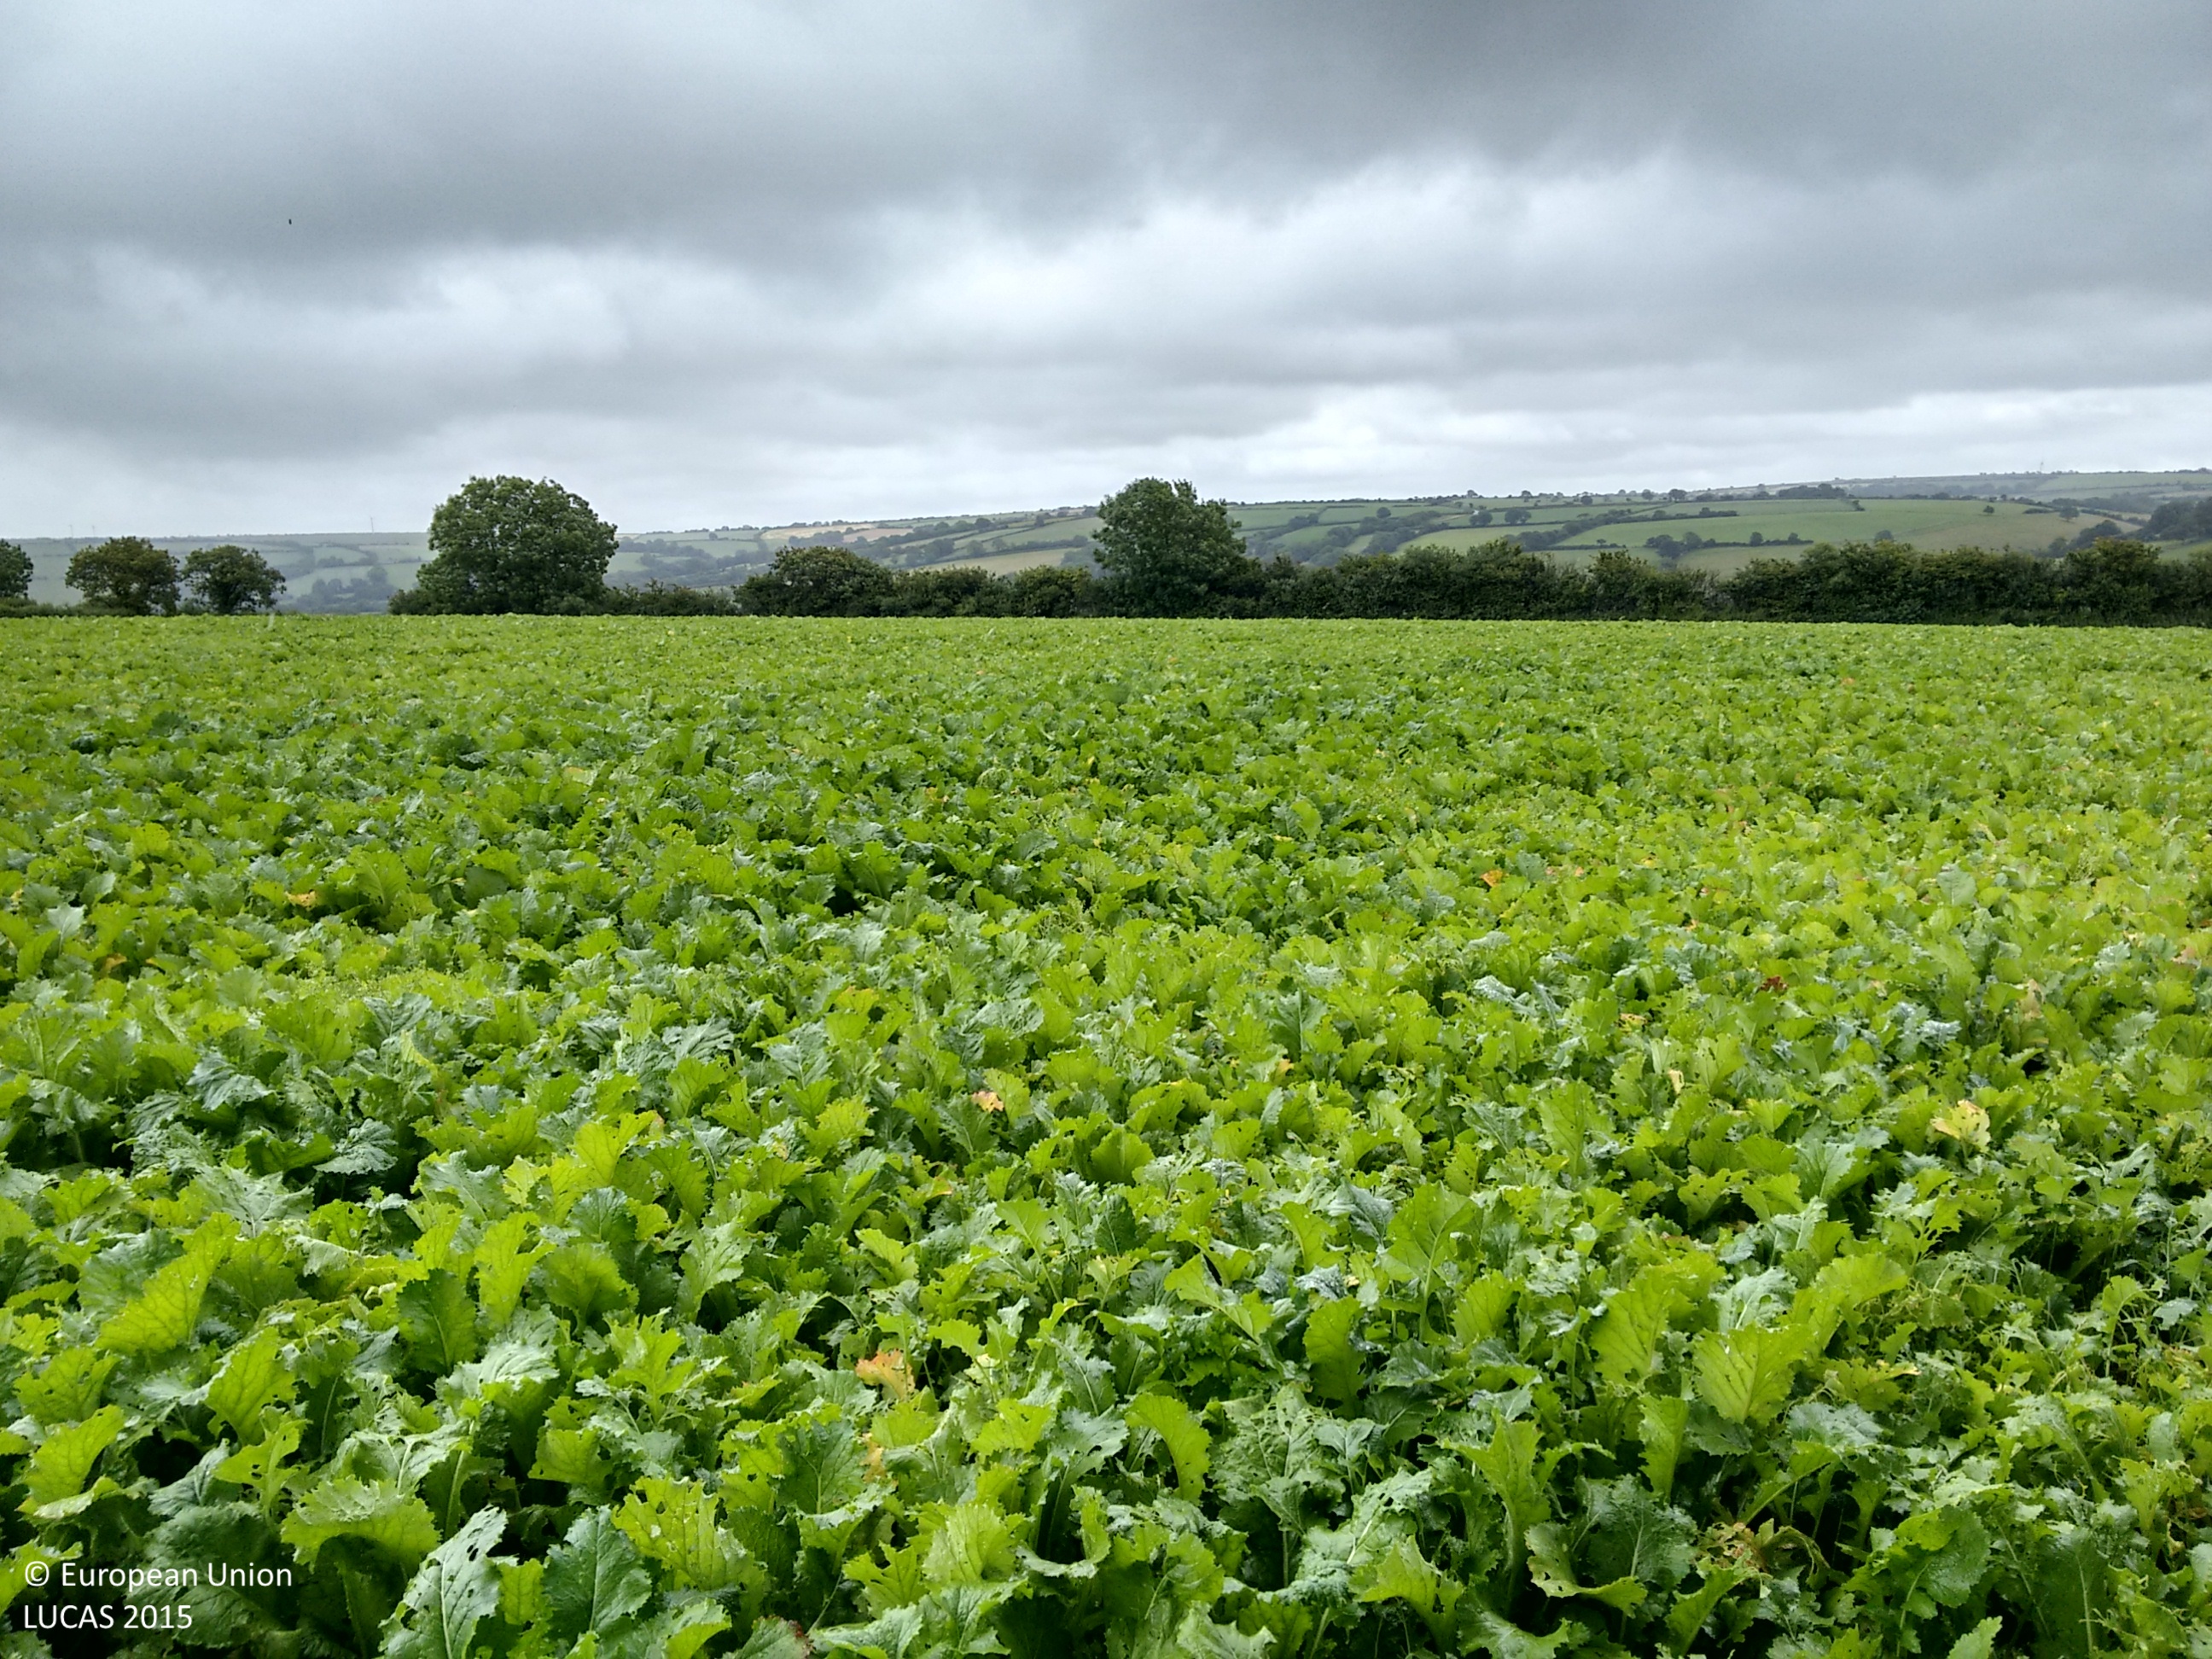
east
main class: Cropland
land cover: Other root crops
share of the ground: > 75 %
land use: Agriculture (excluding fallow land and kitchen gardens)
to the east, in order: Managed hedges; Fences; Other root crops; Fences; Managed hedges; Fences; Grassland without tree/shrub cover
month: August
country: GB
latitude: 51.9421
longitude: -4.6114
